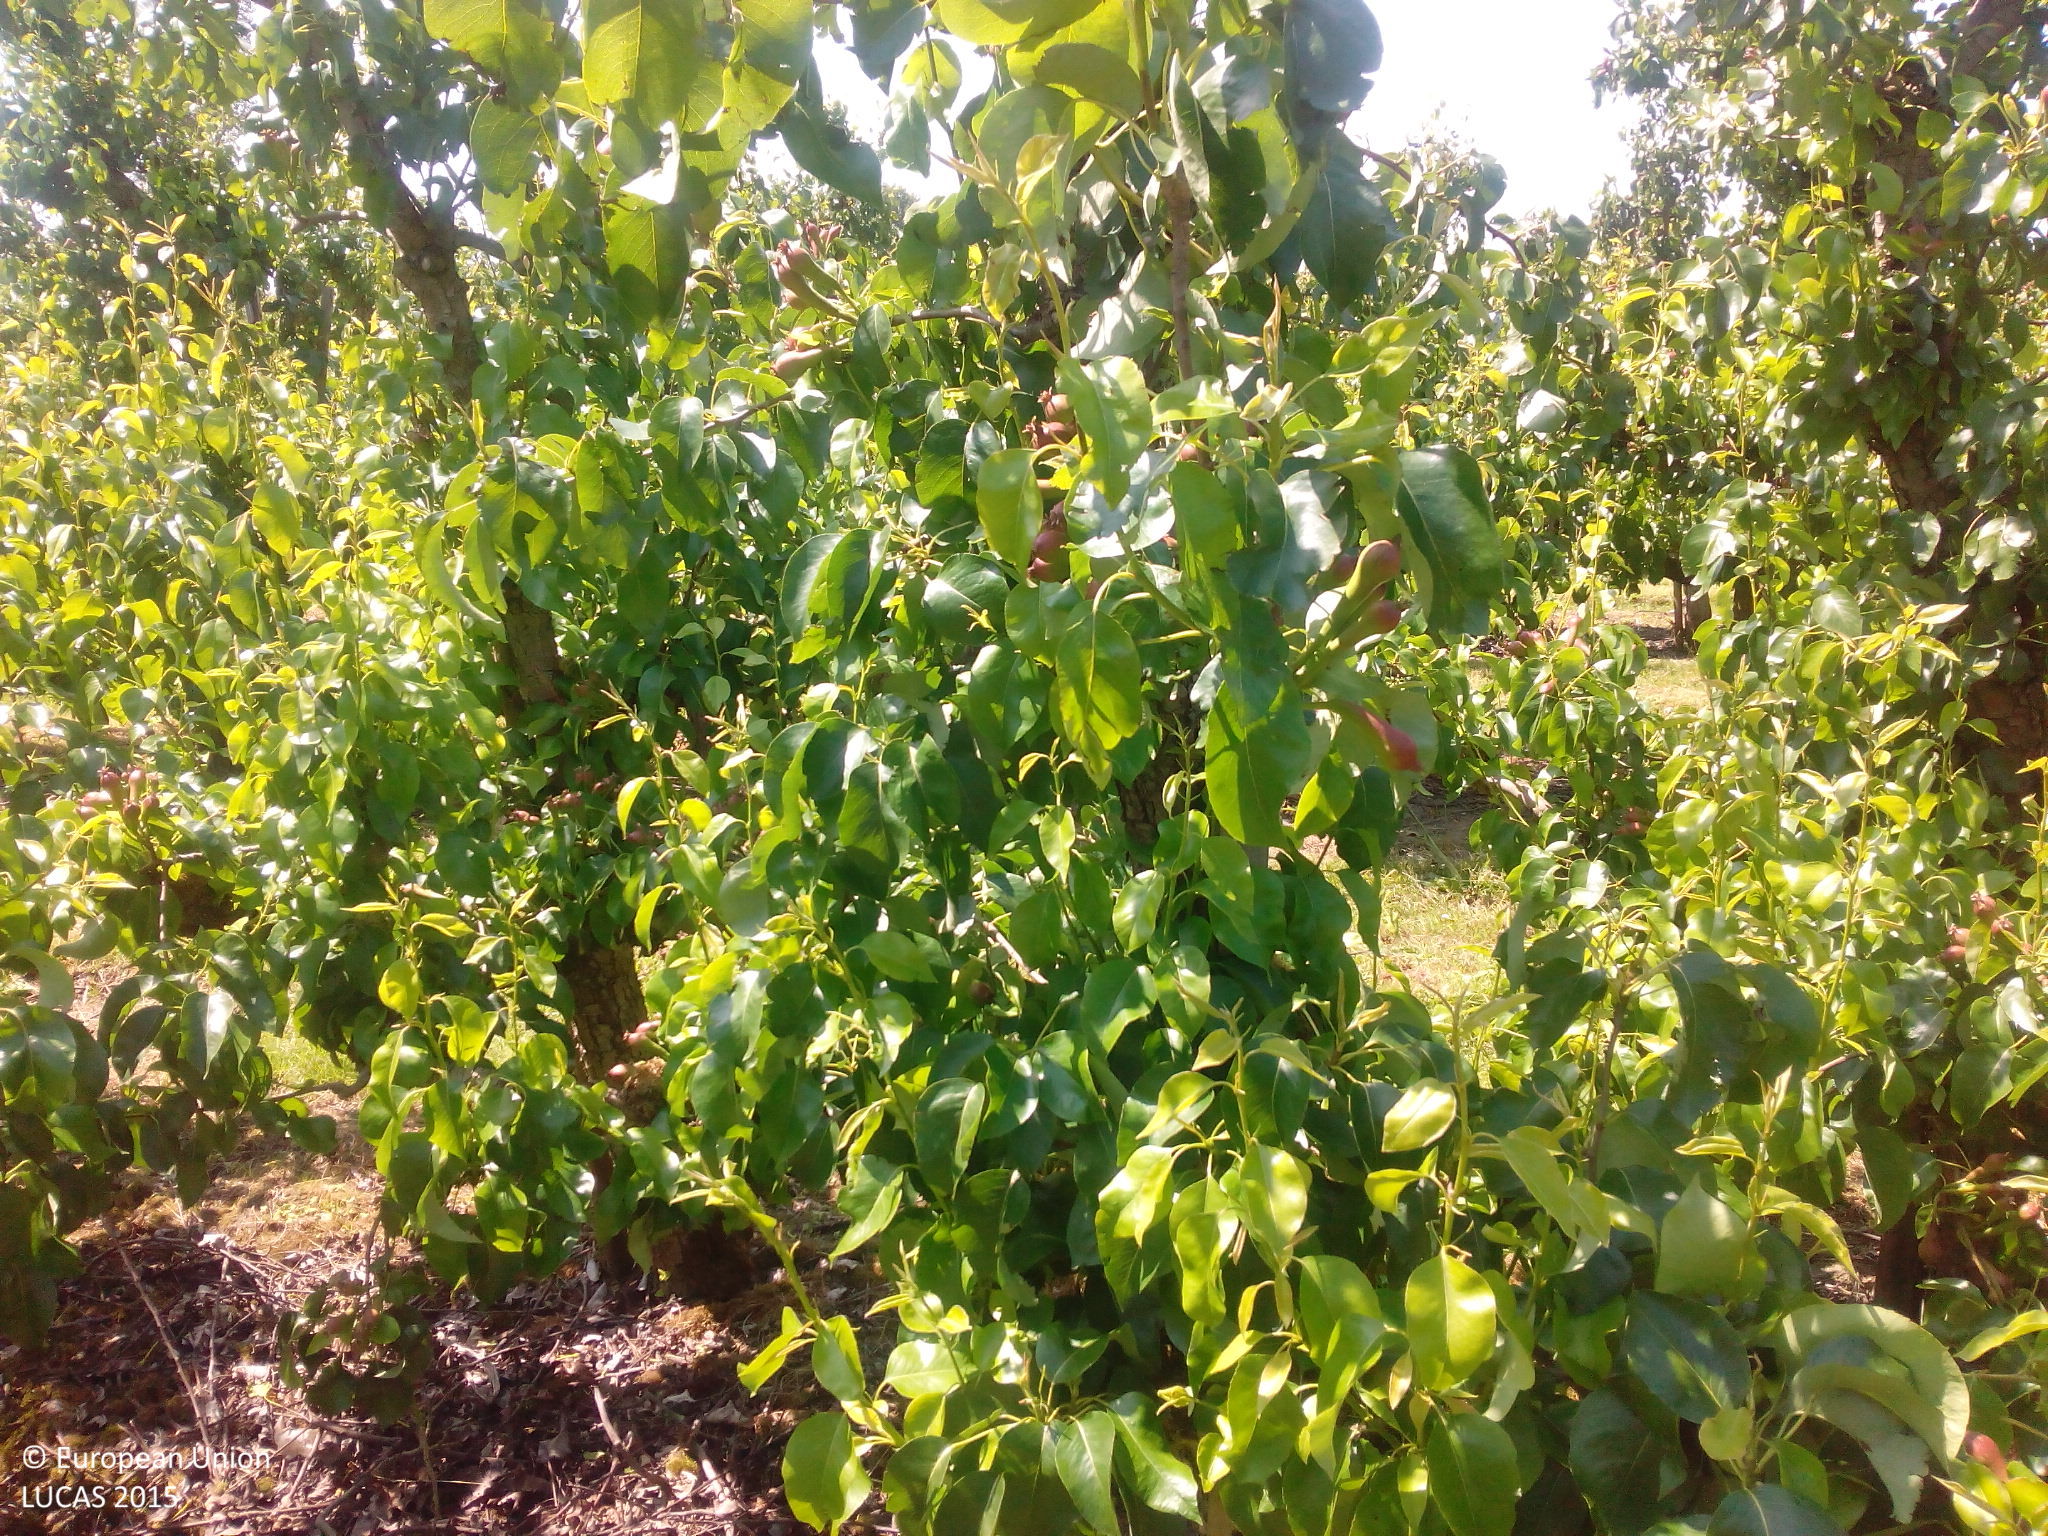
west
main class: Cropland
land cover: Pear fruit
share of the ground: > 75 %
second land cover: Grassland without tree/shrub cover
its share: > 75 %
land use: Agriculture (excluding fallow land and kitchen gardens)
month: June
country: NL
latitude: 51.4203
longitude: 4.1130
